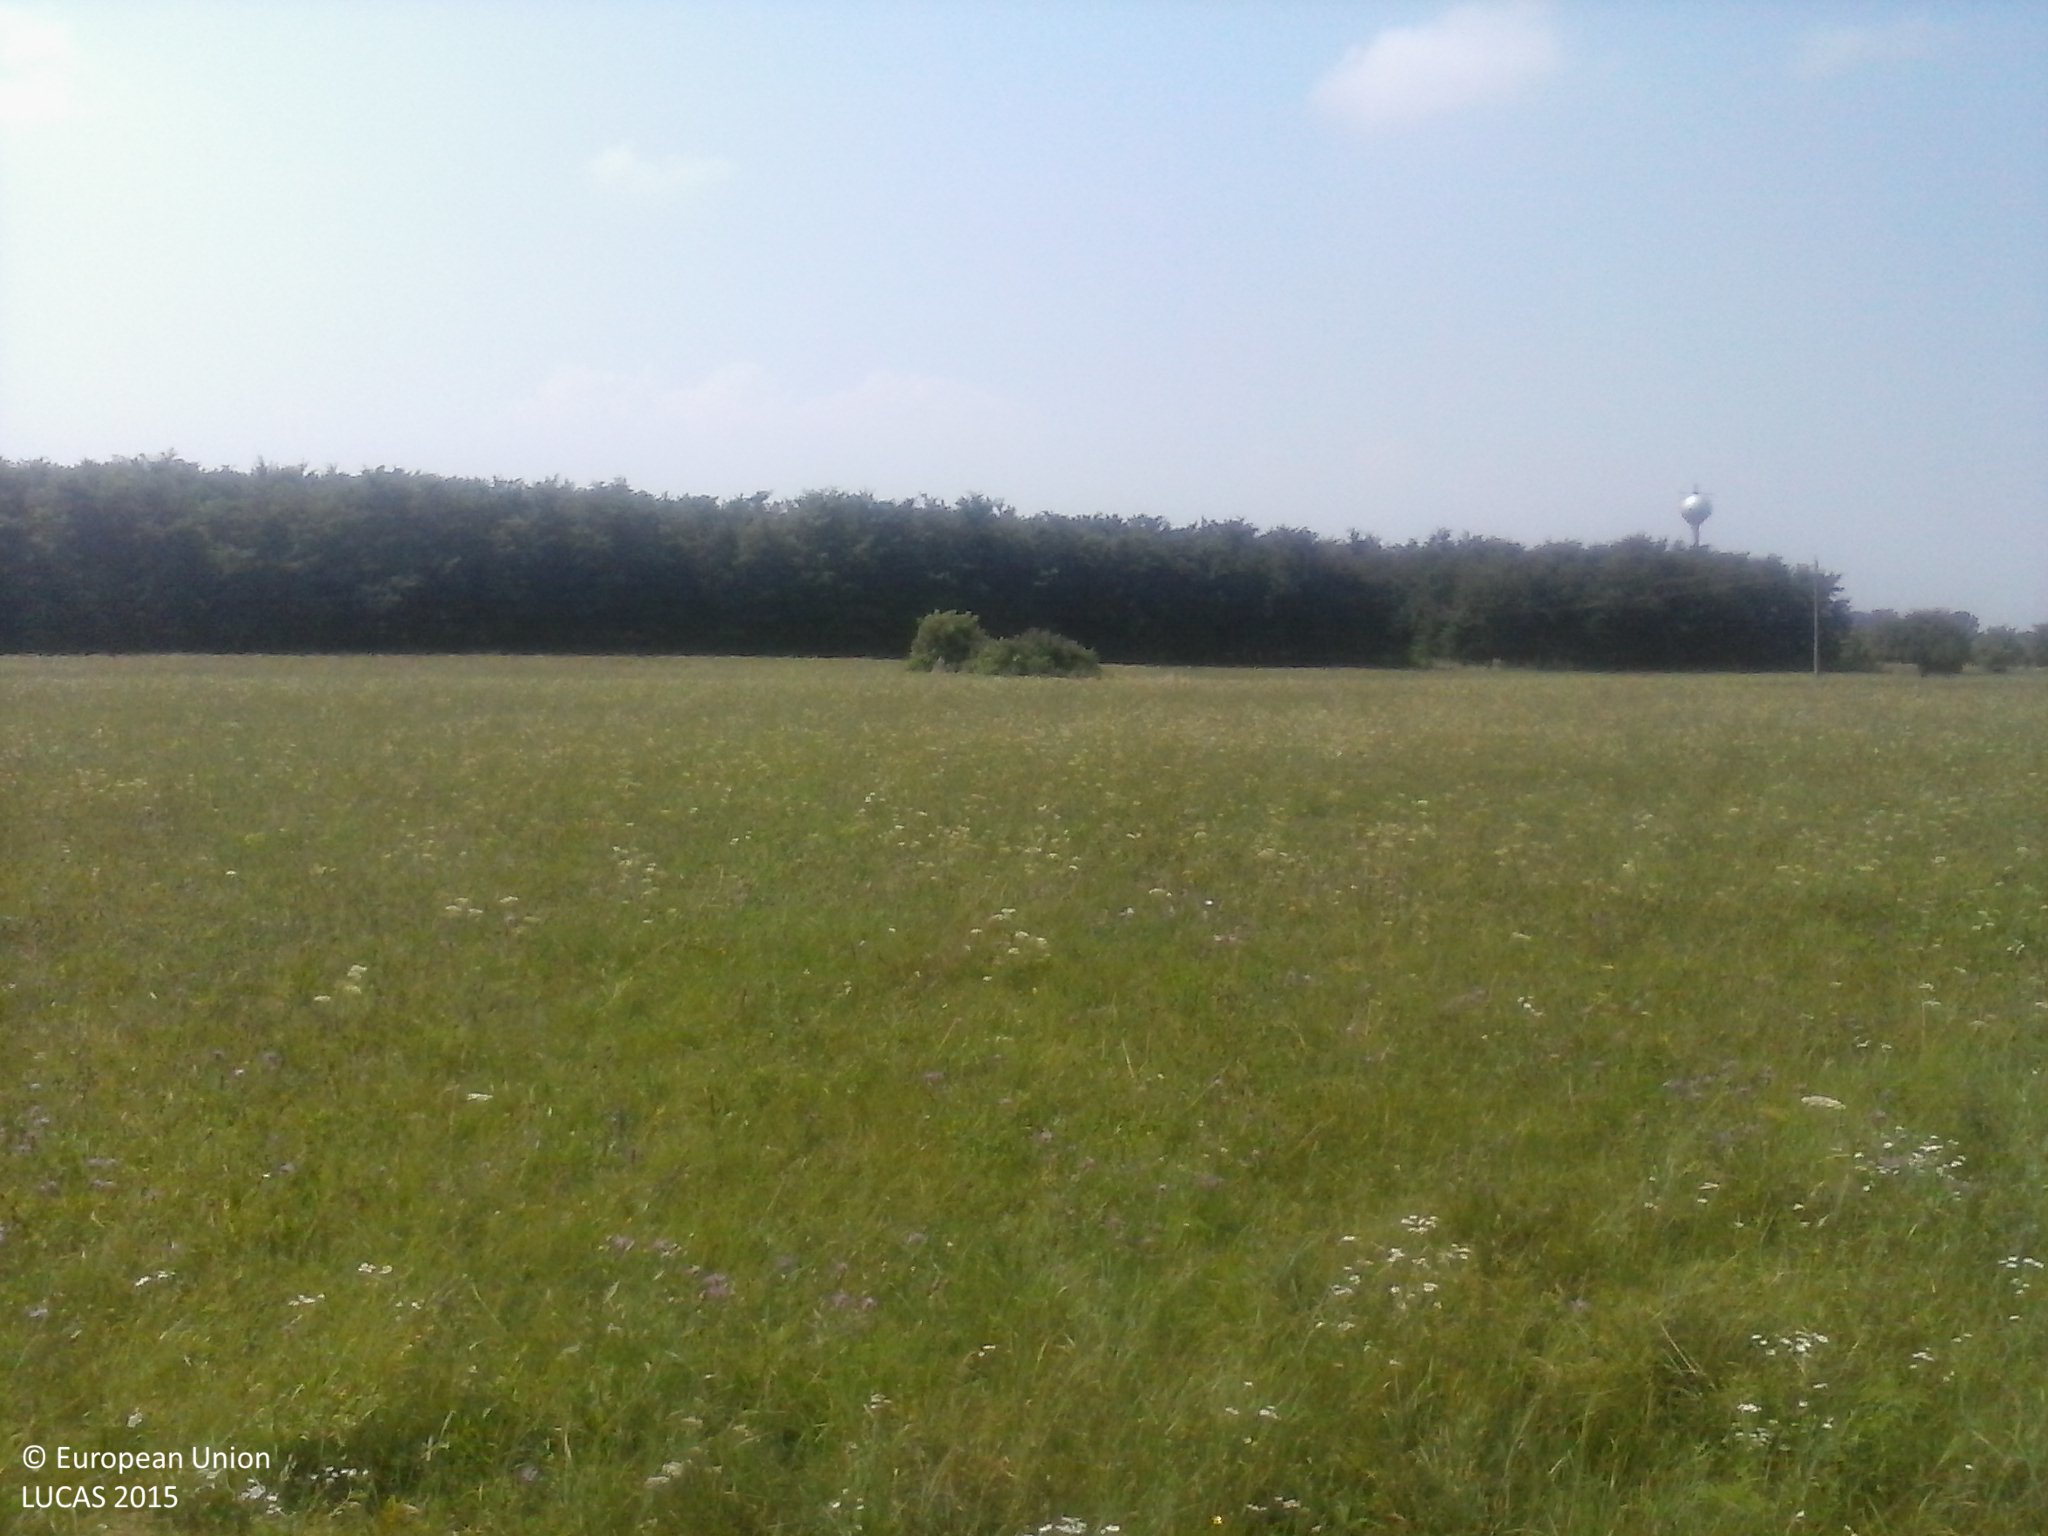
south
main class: Grassland
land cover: Grassland without tree/shrub cover
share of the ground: > 75 %
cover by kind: herbaceous plants 100 %
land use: Agriculture (excluding fallow land and kitchen gardens)
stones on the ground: < 10 %
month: August
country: HU
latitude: 45.8870
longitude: 17.7745
